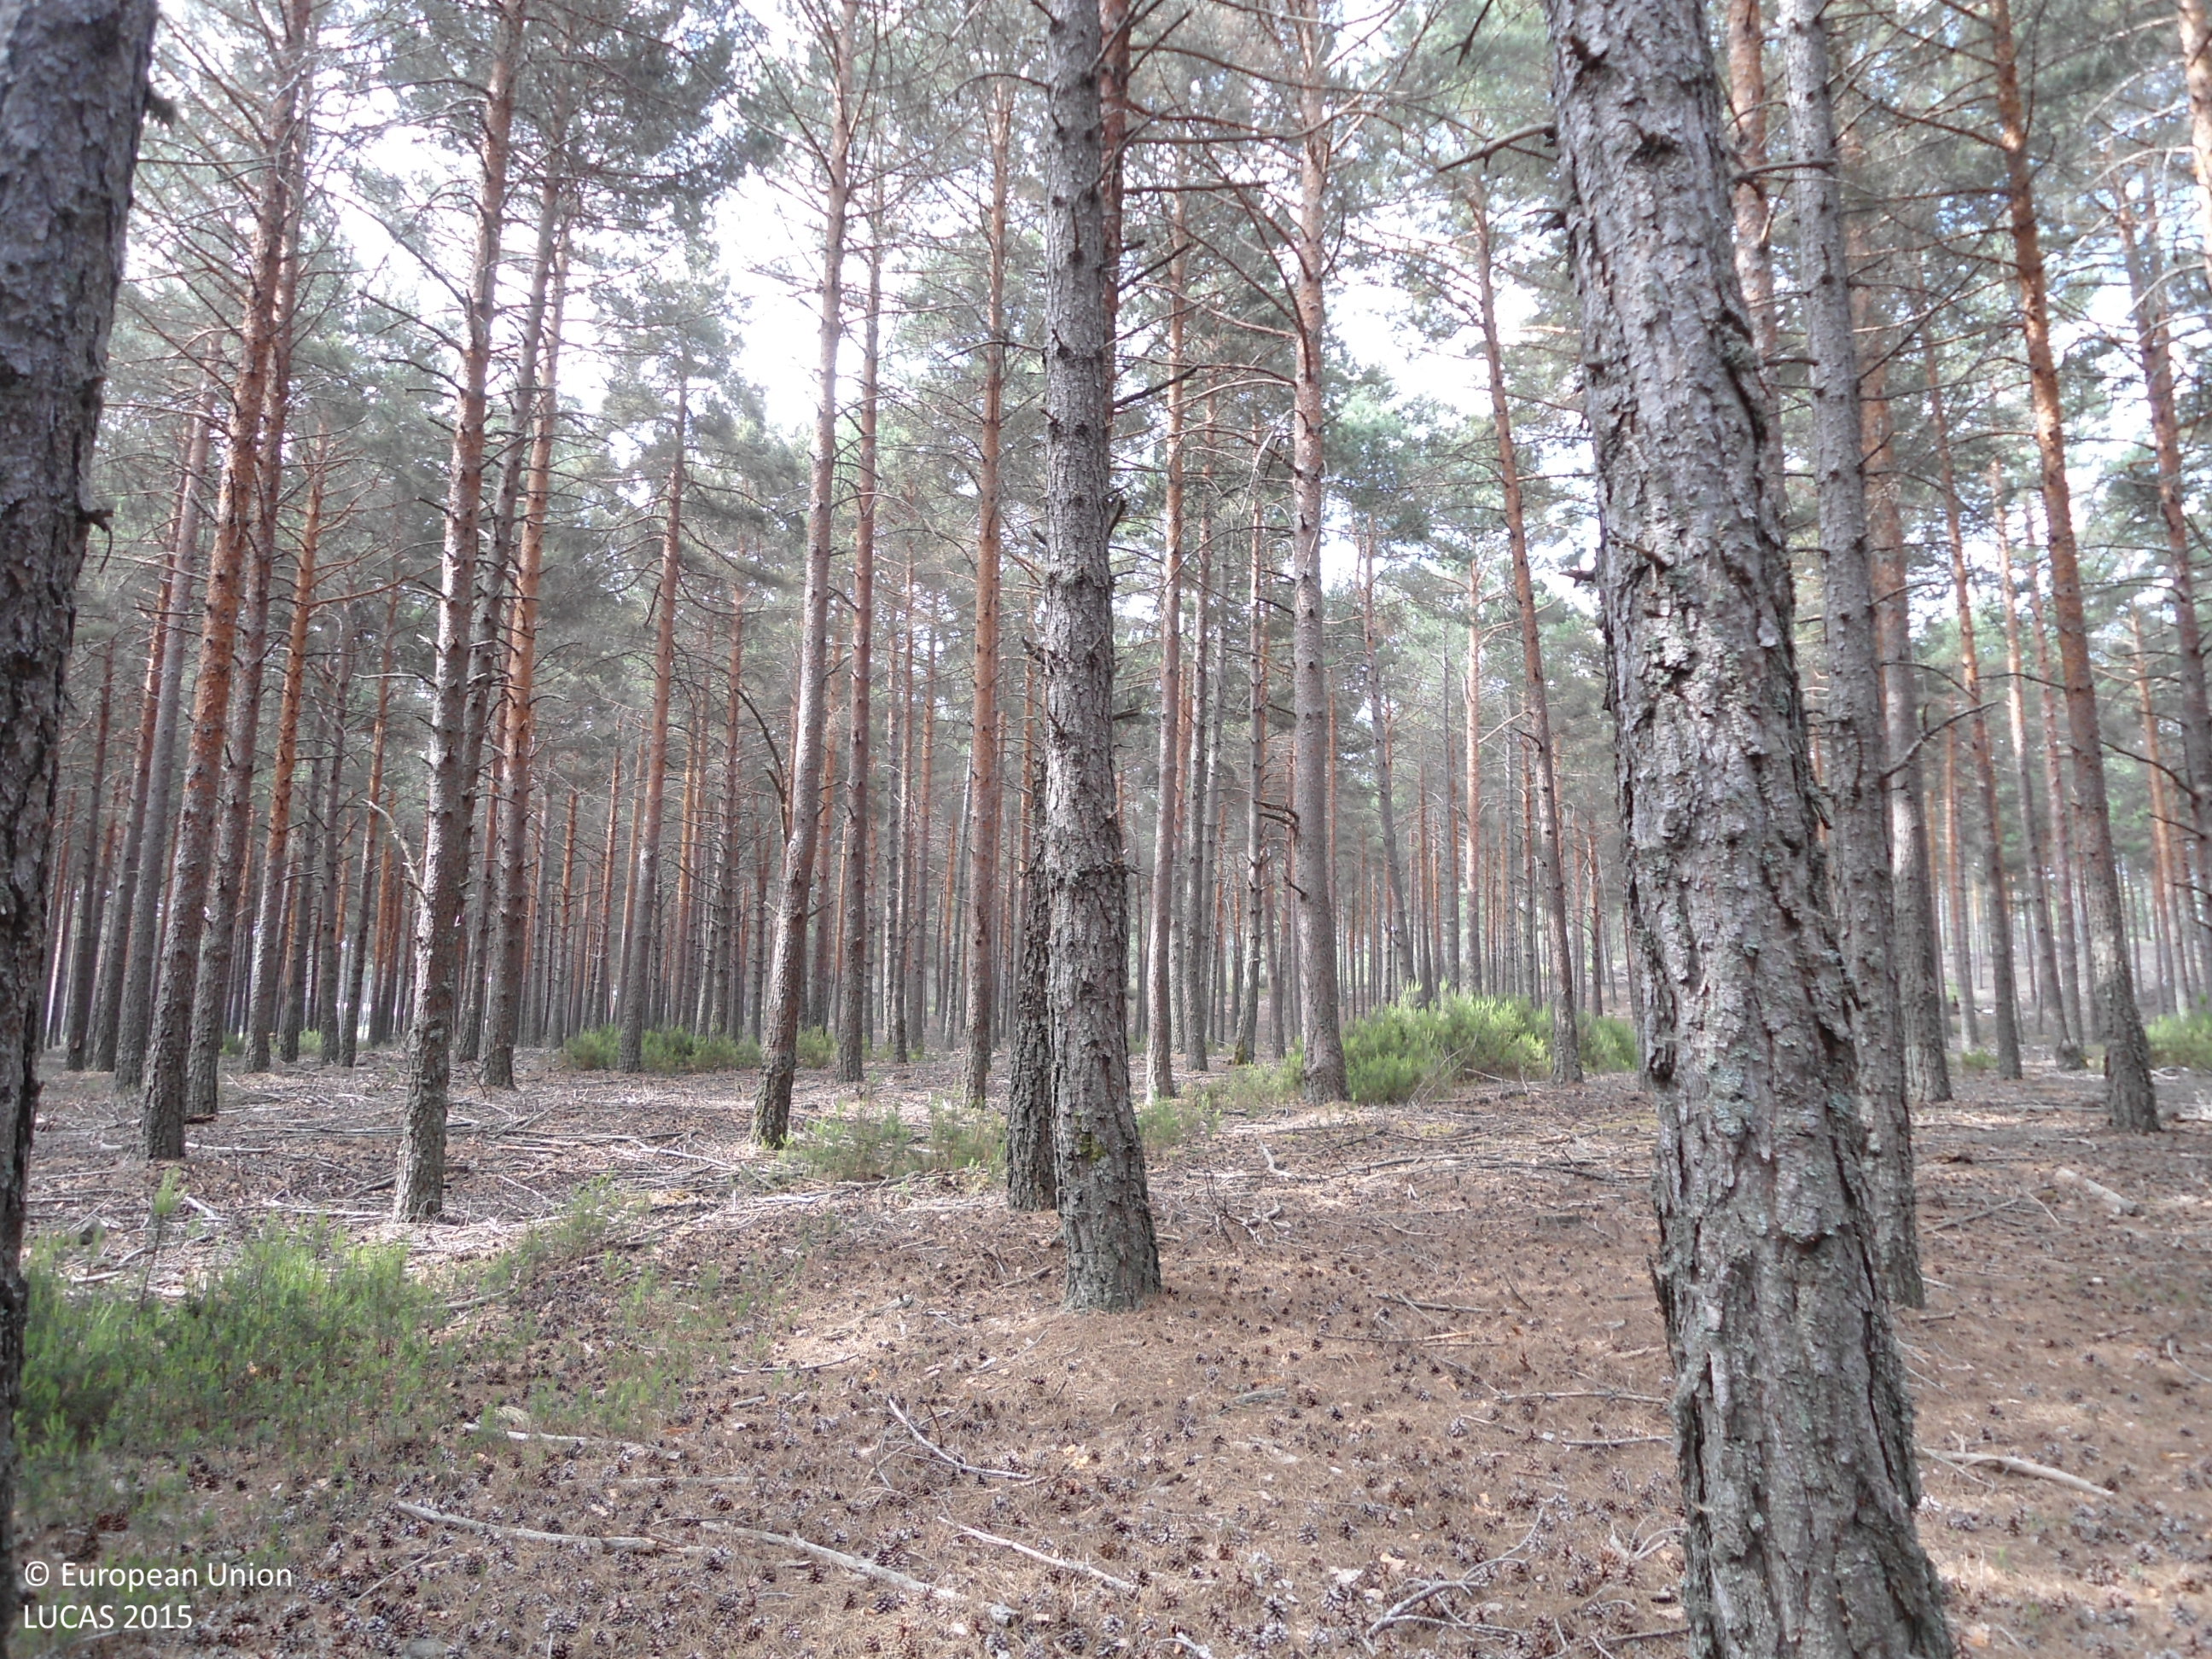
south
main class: Woodland
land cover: Pine dominated coniferous woodland
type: coniferous forest of the mediterranean region
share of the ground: > 75 %
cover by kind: coniferous forest trees 100 %
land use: Forestry
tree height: > 5 m
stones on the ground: < 10 %
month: June
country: ES
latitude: 41.9924
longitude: -6.5892
